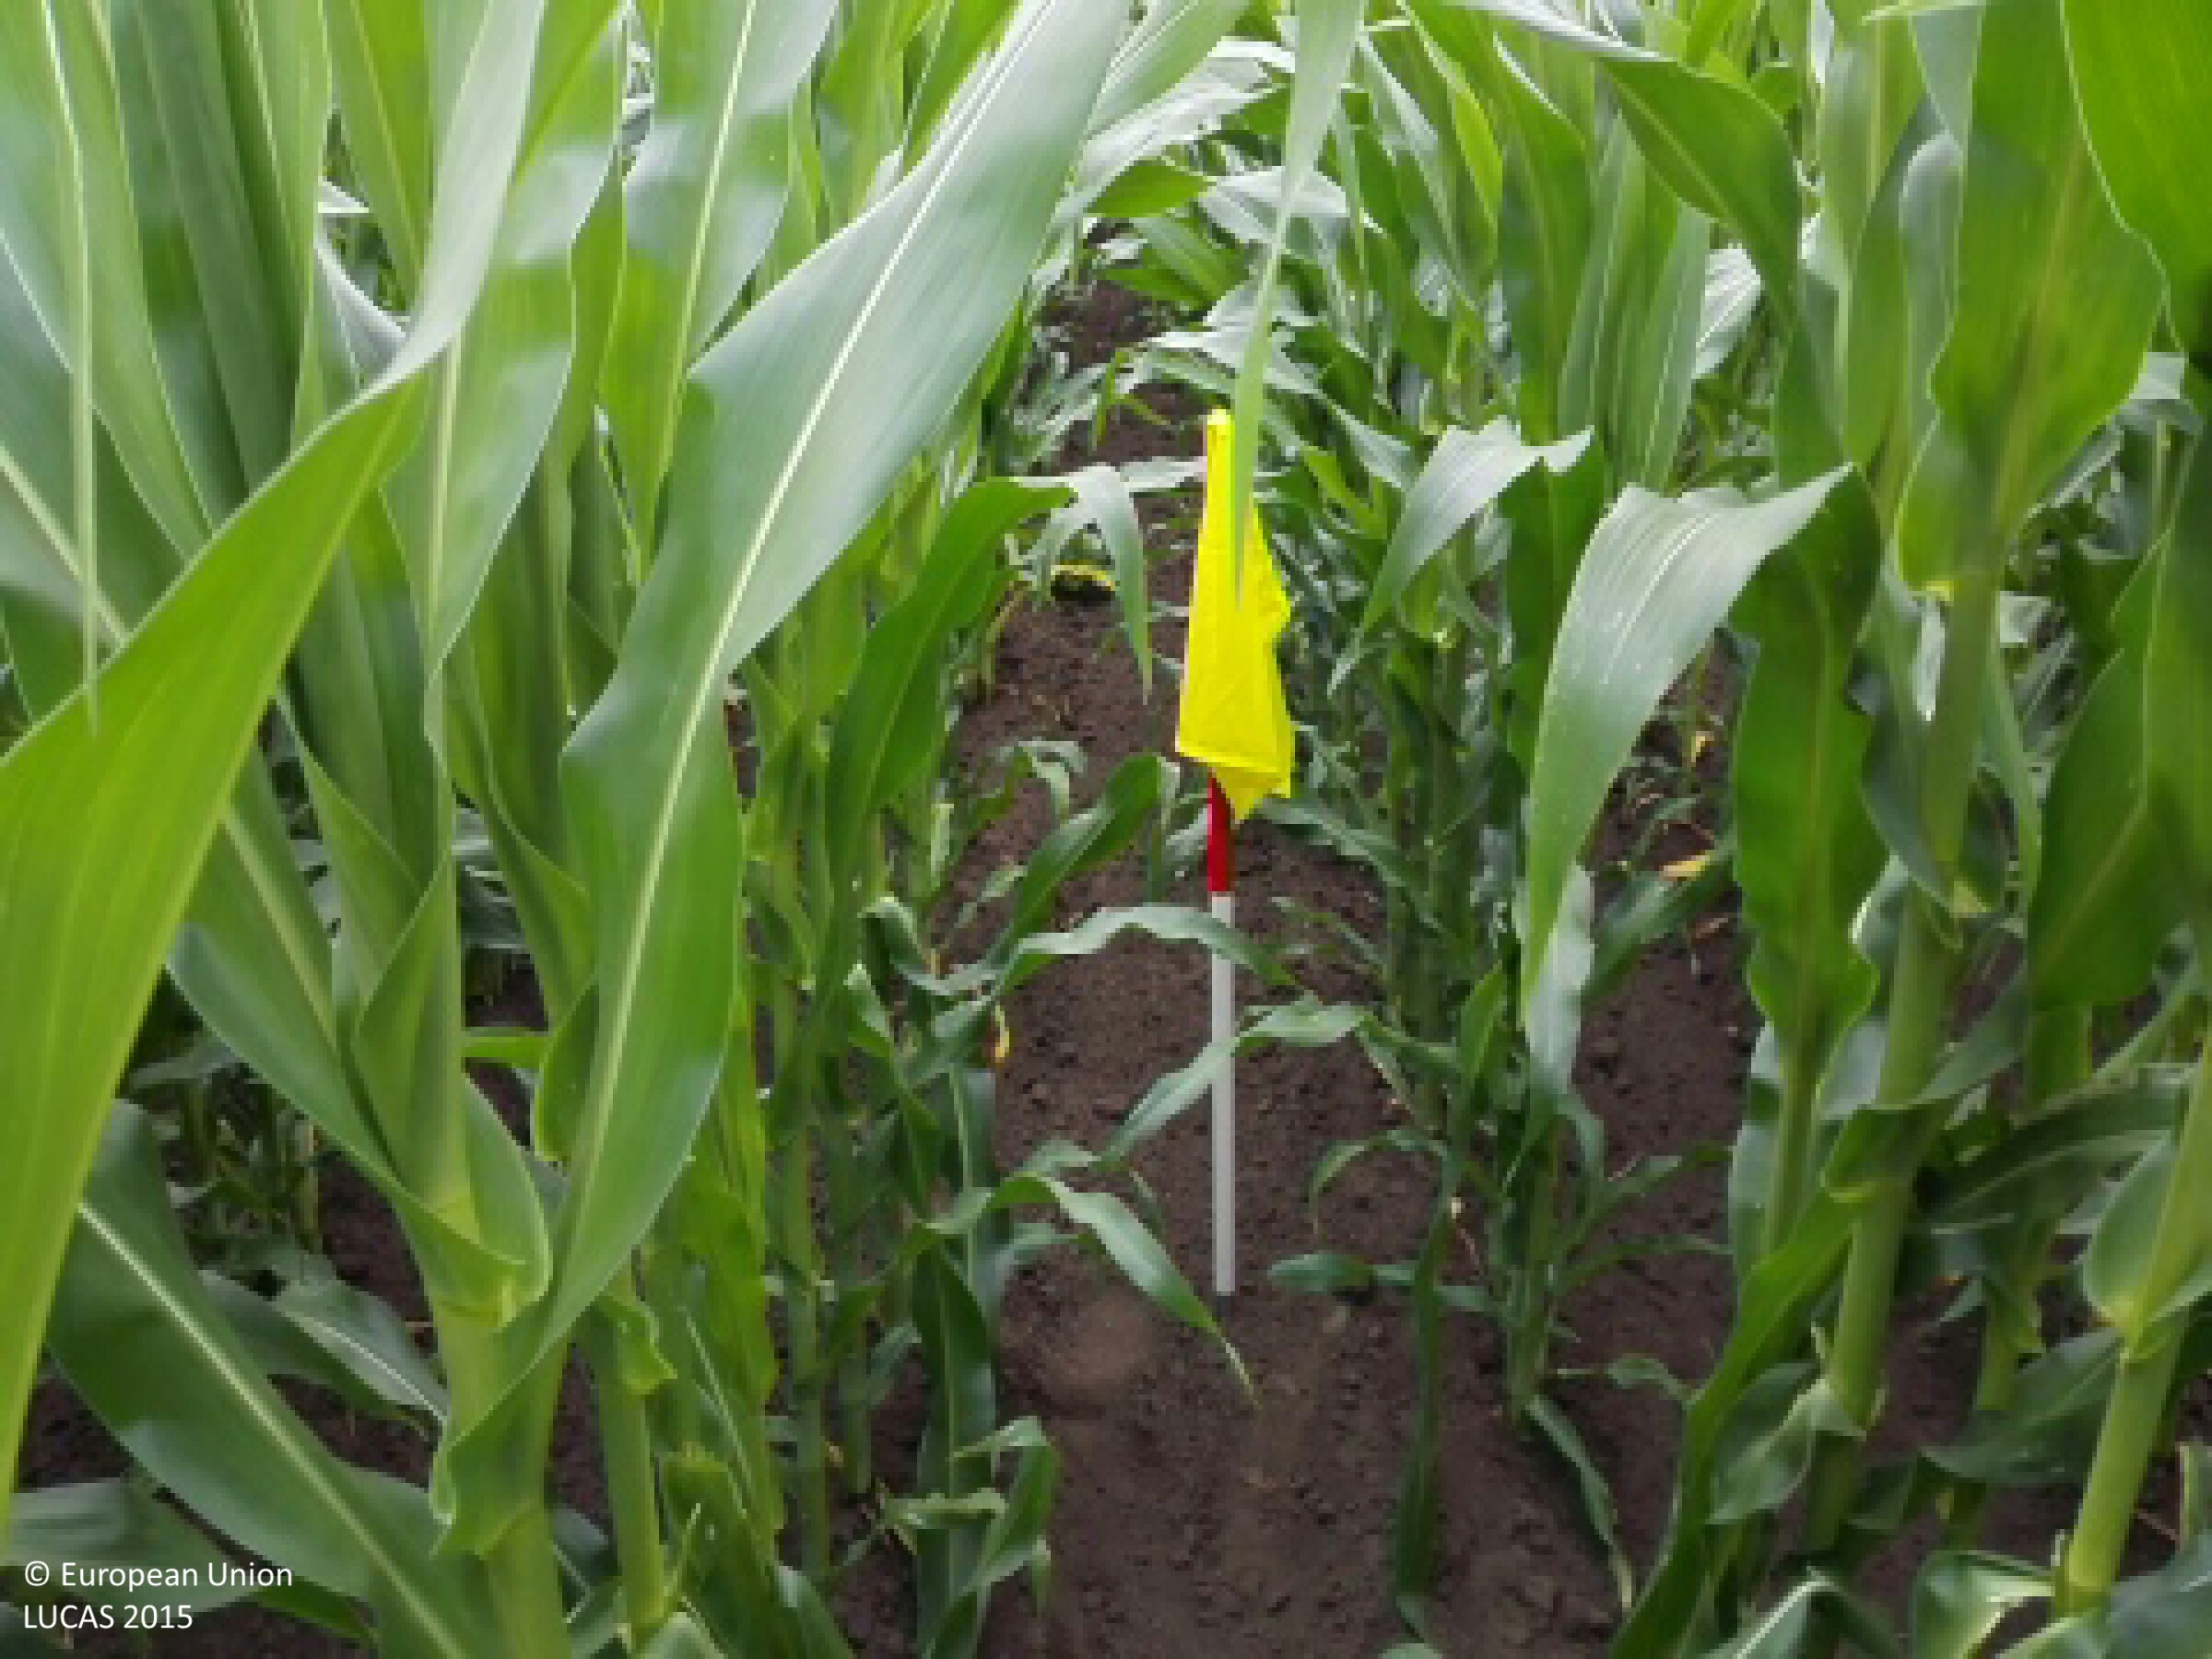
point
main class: Cropland
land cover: Maize
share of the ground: > 75 %
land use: Agriculture (excluding fallow land and kitchen gardens)
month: June
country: HU
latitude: 47.7148
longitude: 21.6289
